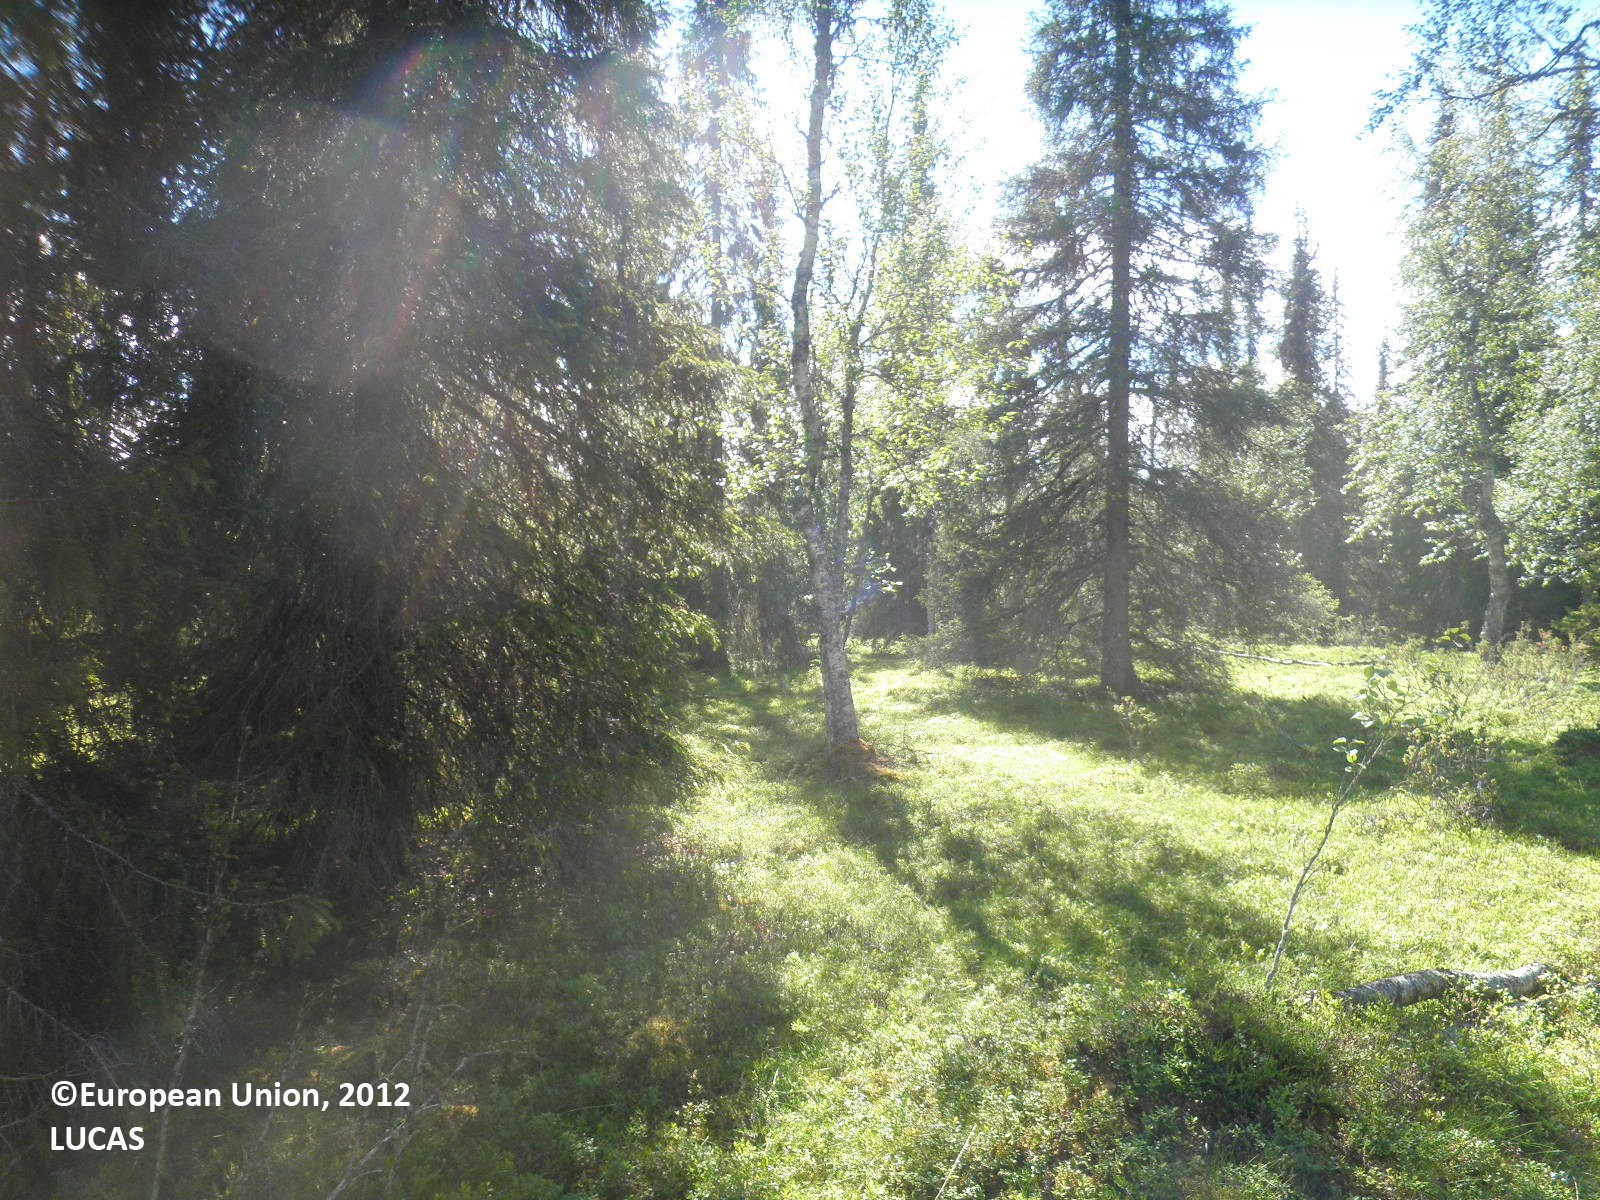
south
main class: Woodland
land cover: Spruce dominated mixed woodland
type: boreal forest
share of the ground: 50 - 75 %
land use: Forestry
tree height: > 5 m
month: July
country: FI
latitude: 67.9263
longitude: 26.1516
